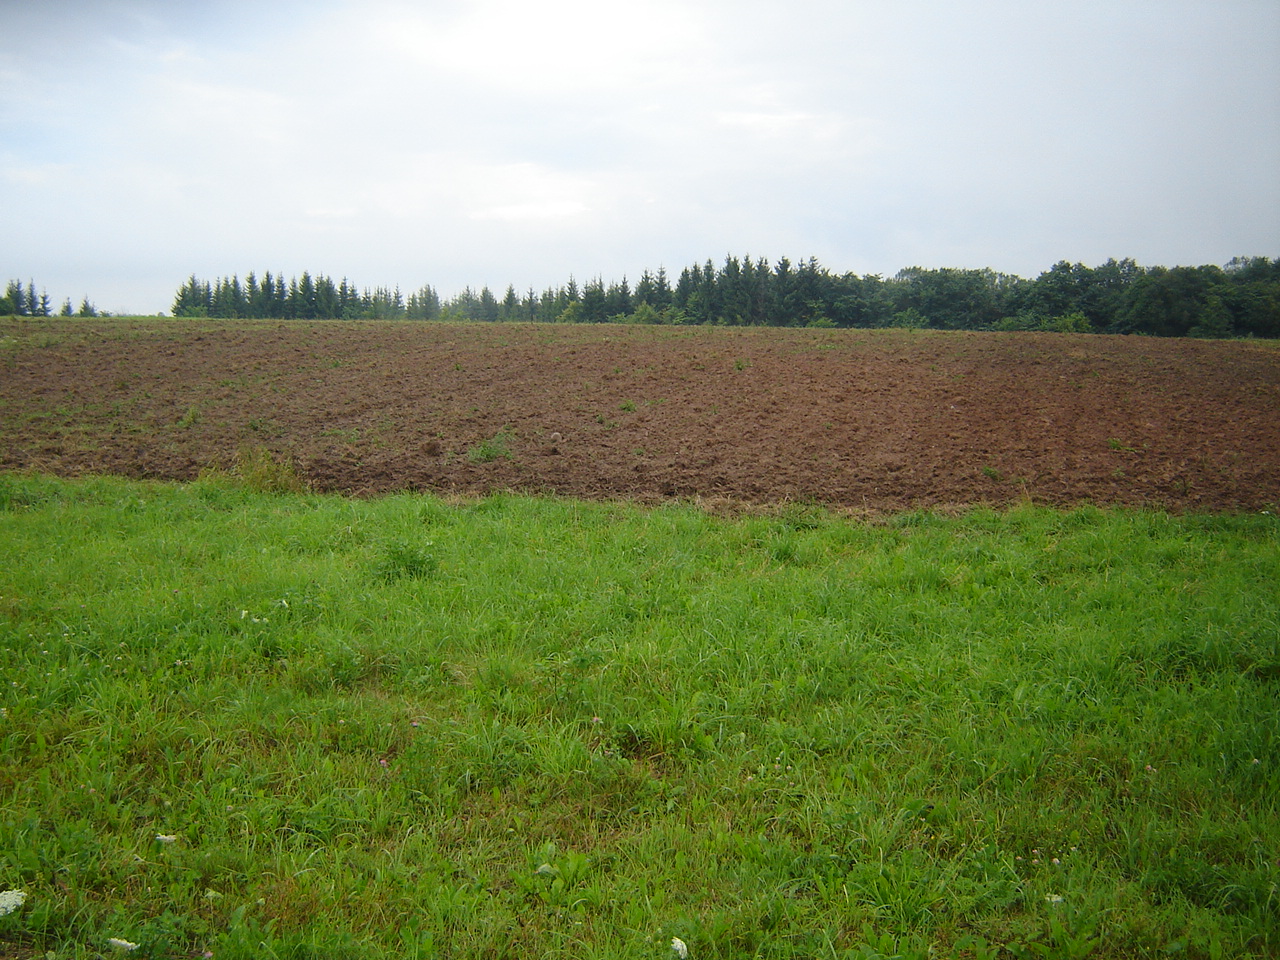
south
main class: Grassland
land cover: Grassland without tree/shrub cover
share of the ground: > 75 %
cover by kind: herbaceous plants 100 %
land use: Agriculture (excluding fallow land and kitchen gardens)
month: July
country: LT
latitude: 55.4355
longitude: 25.0812
